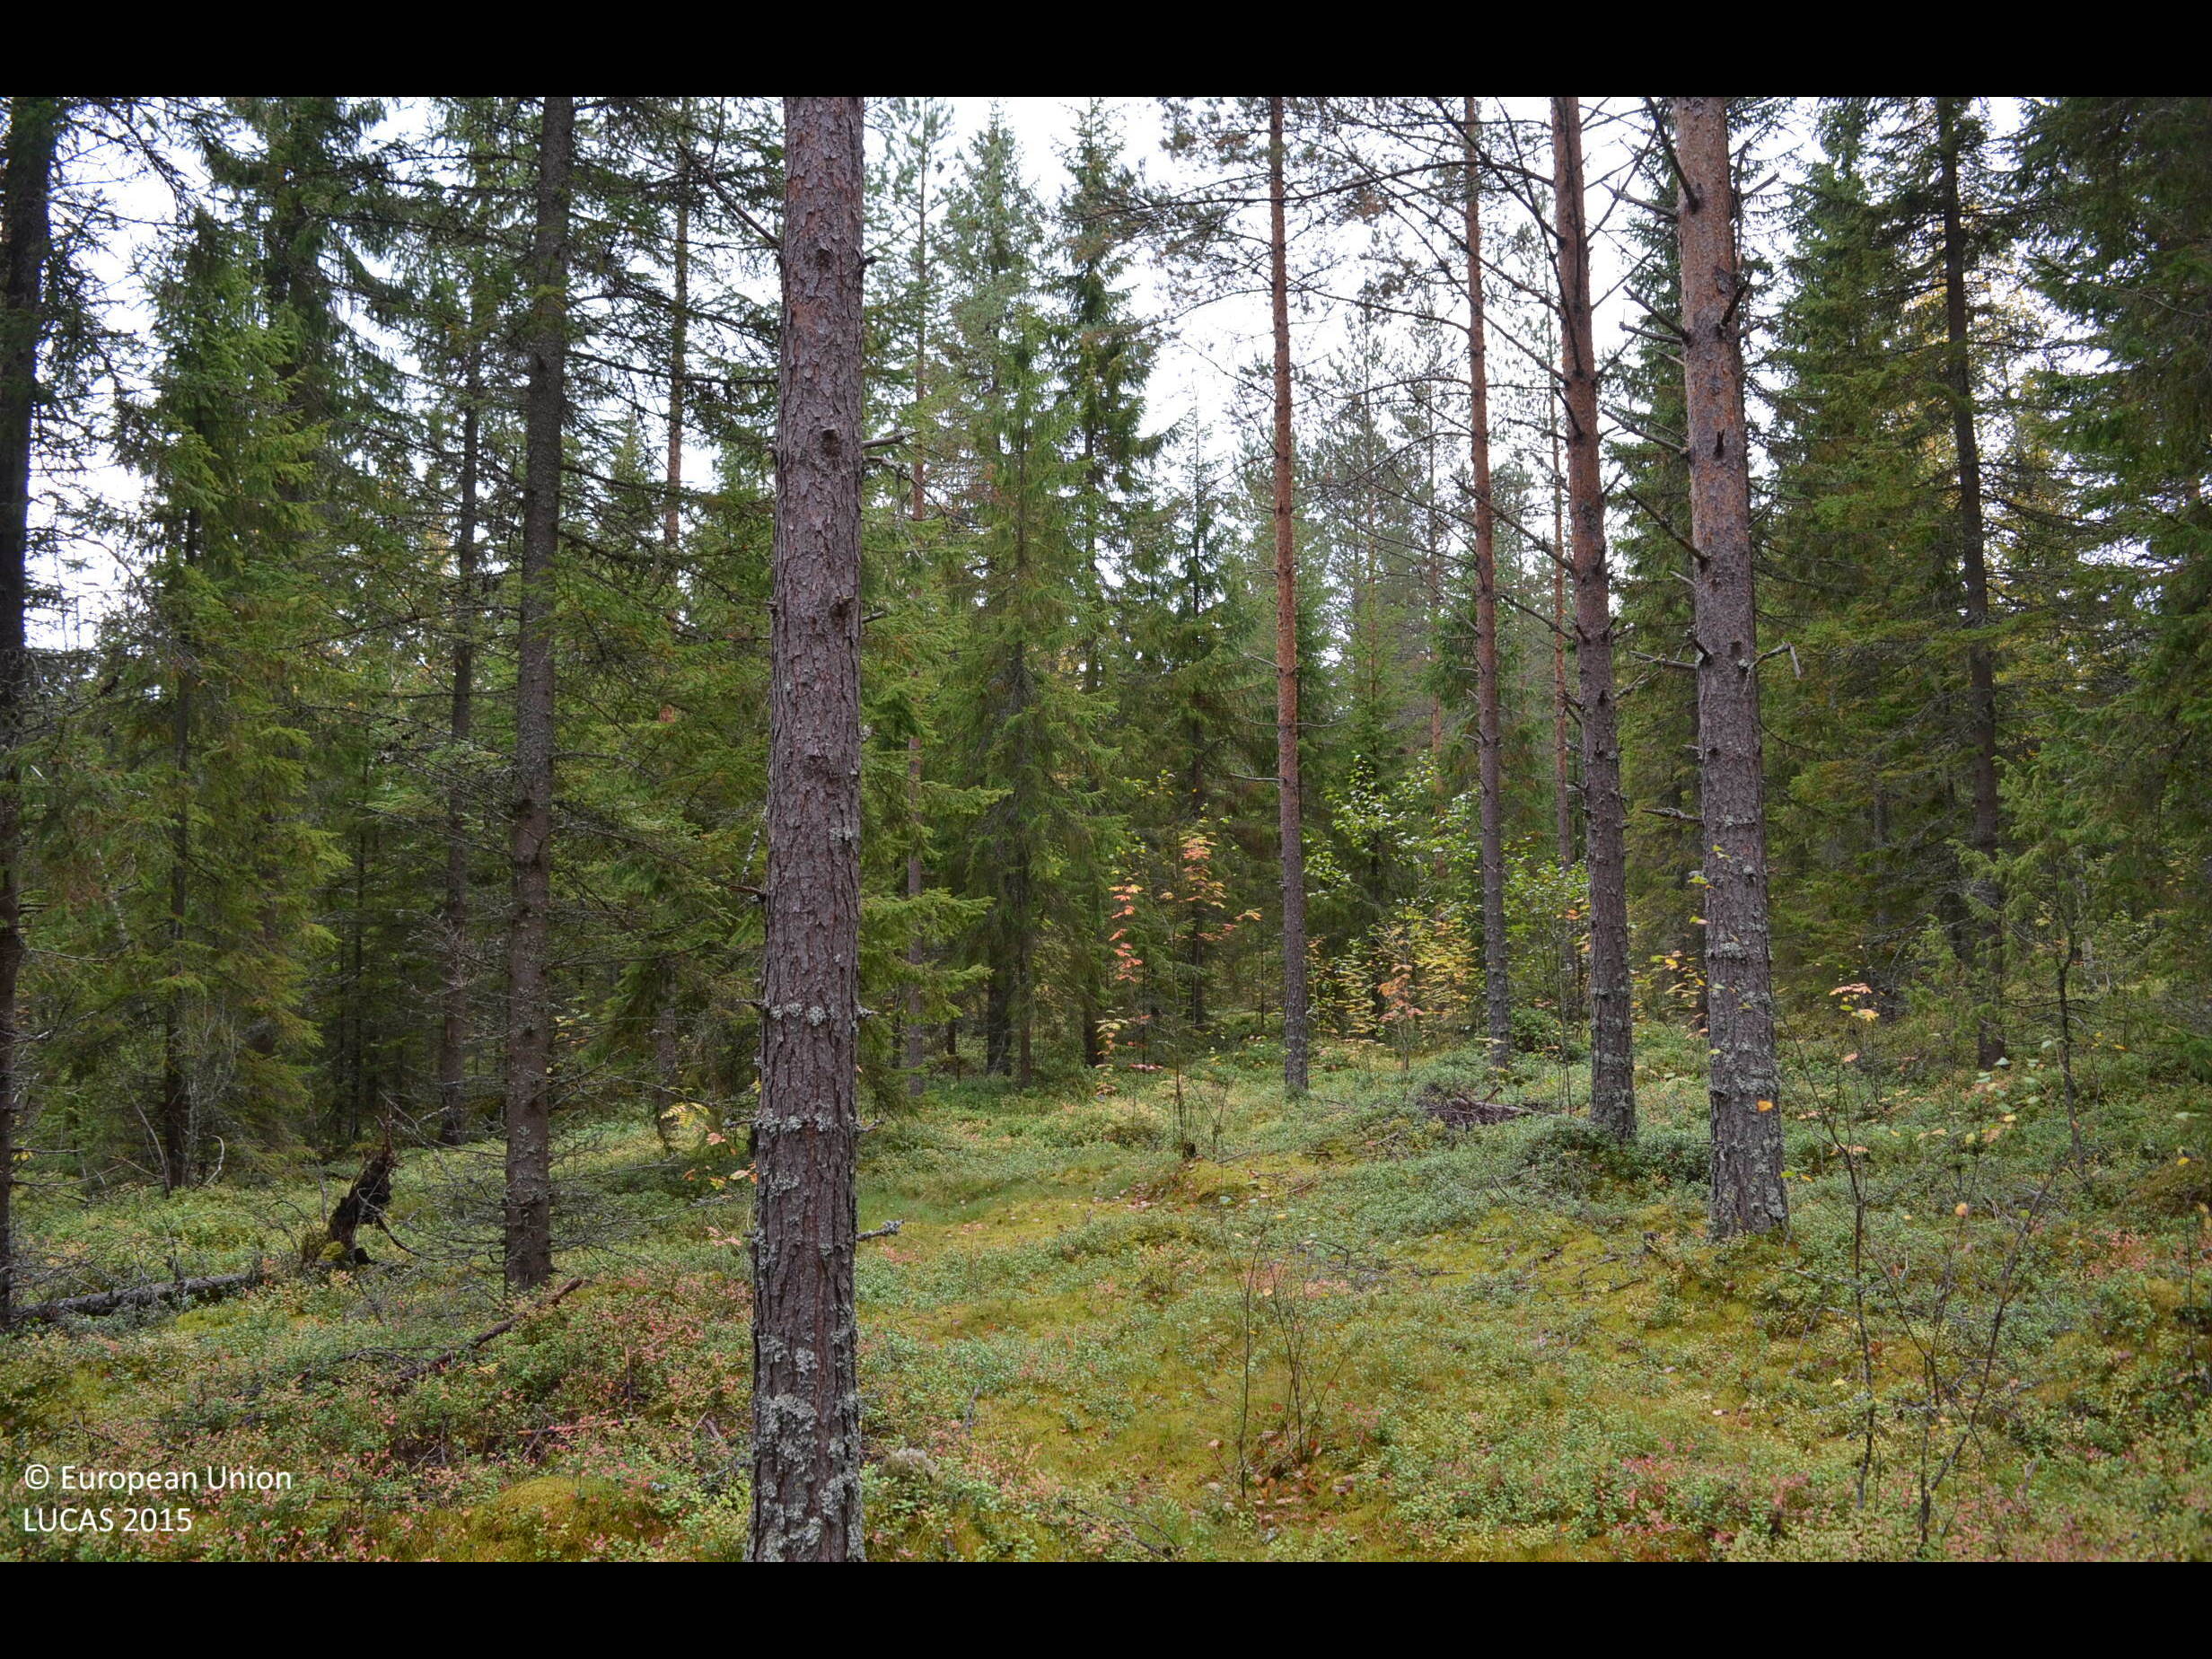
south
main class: Woodland
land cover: Other mixed woodland
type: boreal forest
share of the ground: 50 - 75 %
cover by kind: coniferous forest trees 50 %, broadleaved forest trees 20 %, shrubs 20 %, lichens and mosses 10 %
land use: Forestry
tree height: > 5 m
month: September
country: FI
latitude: 62.5683
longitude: 23.7136
